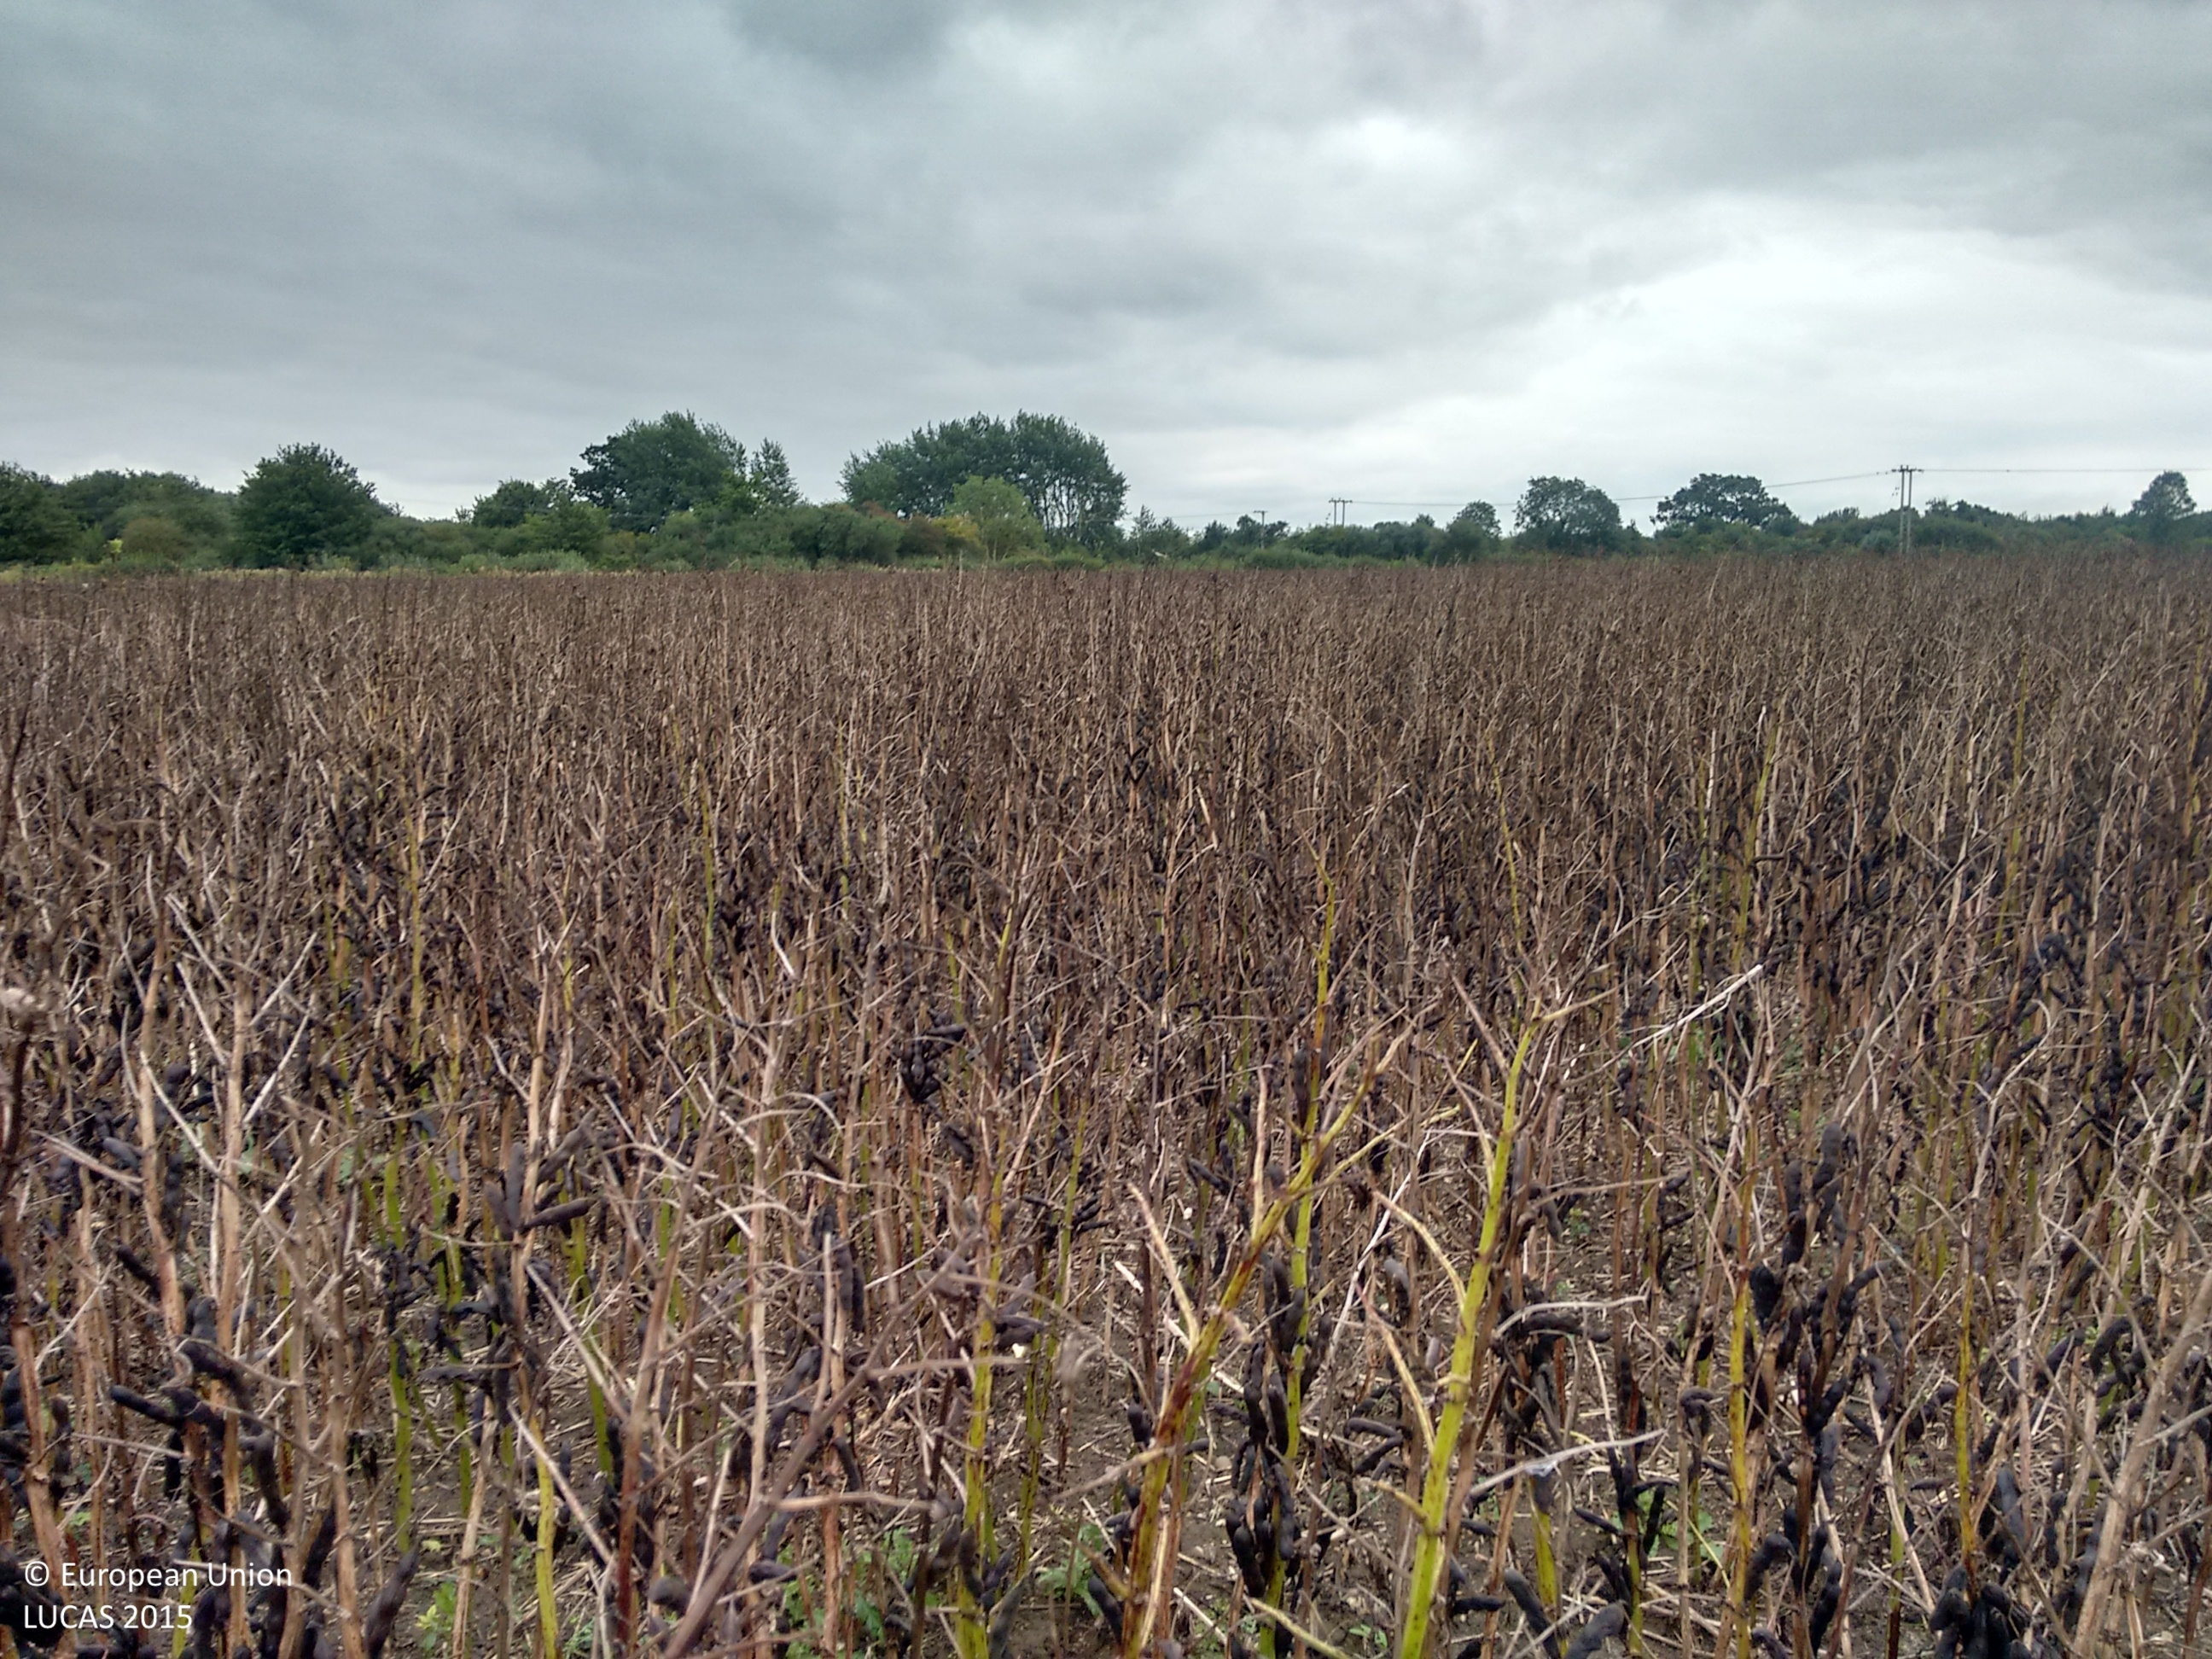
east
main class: Cropland
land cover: Dry pulses
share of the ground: > 75 %
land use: Agriculture (excluding fallow land and kitchen gardens)
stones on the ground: < 10 %
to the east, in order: Dry pulses; Shruby margins; Fences; Railways; Fences; Shruby margins; Grassland without tree/shrub cover; Shrubland with sparse tree cover; Grassland without tree/shrub cover; Electric lines; Grassland without tree/shrub cover; Ditches and canals; Broadleaved woodland; Fences; Grassland without tree/shrub cover
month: September
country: GB
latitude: 52.3260
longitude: 0.3307
